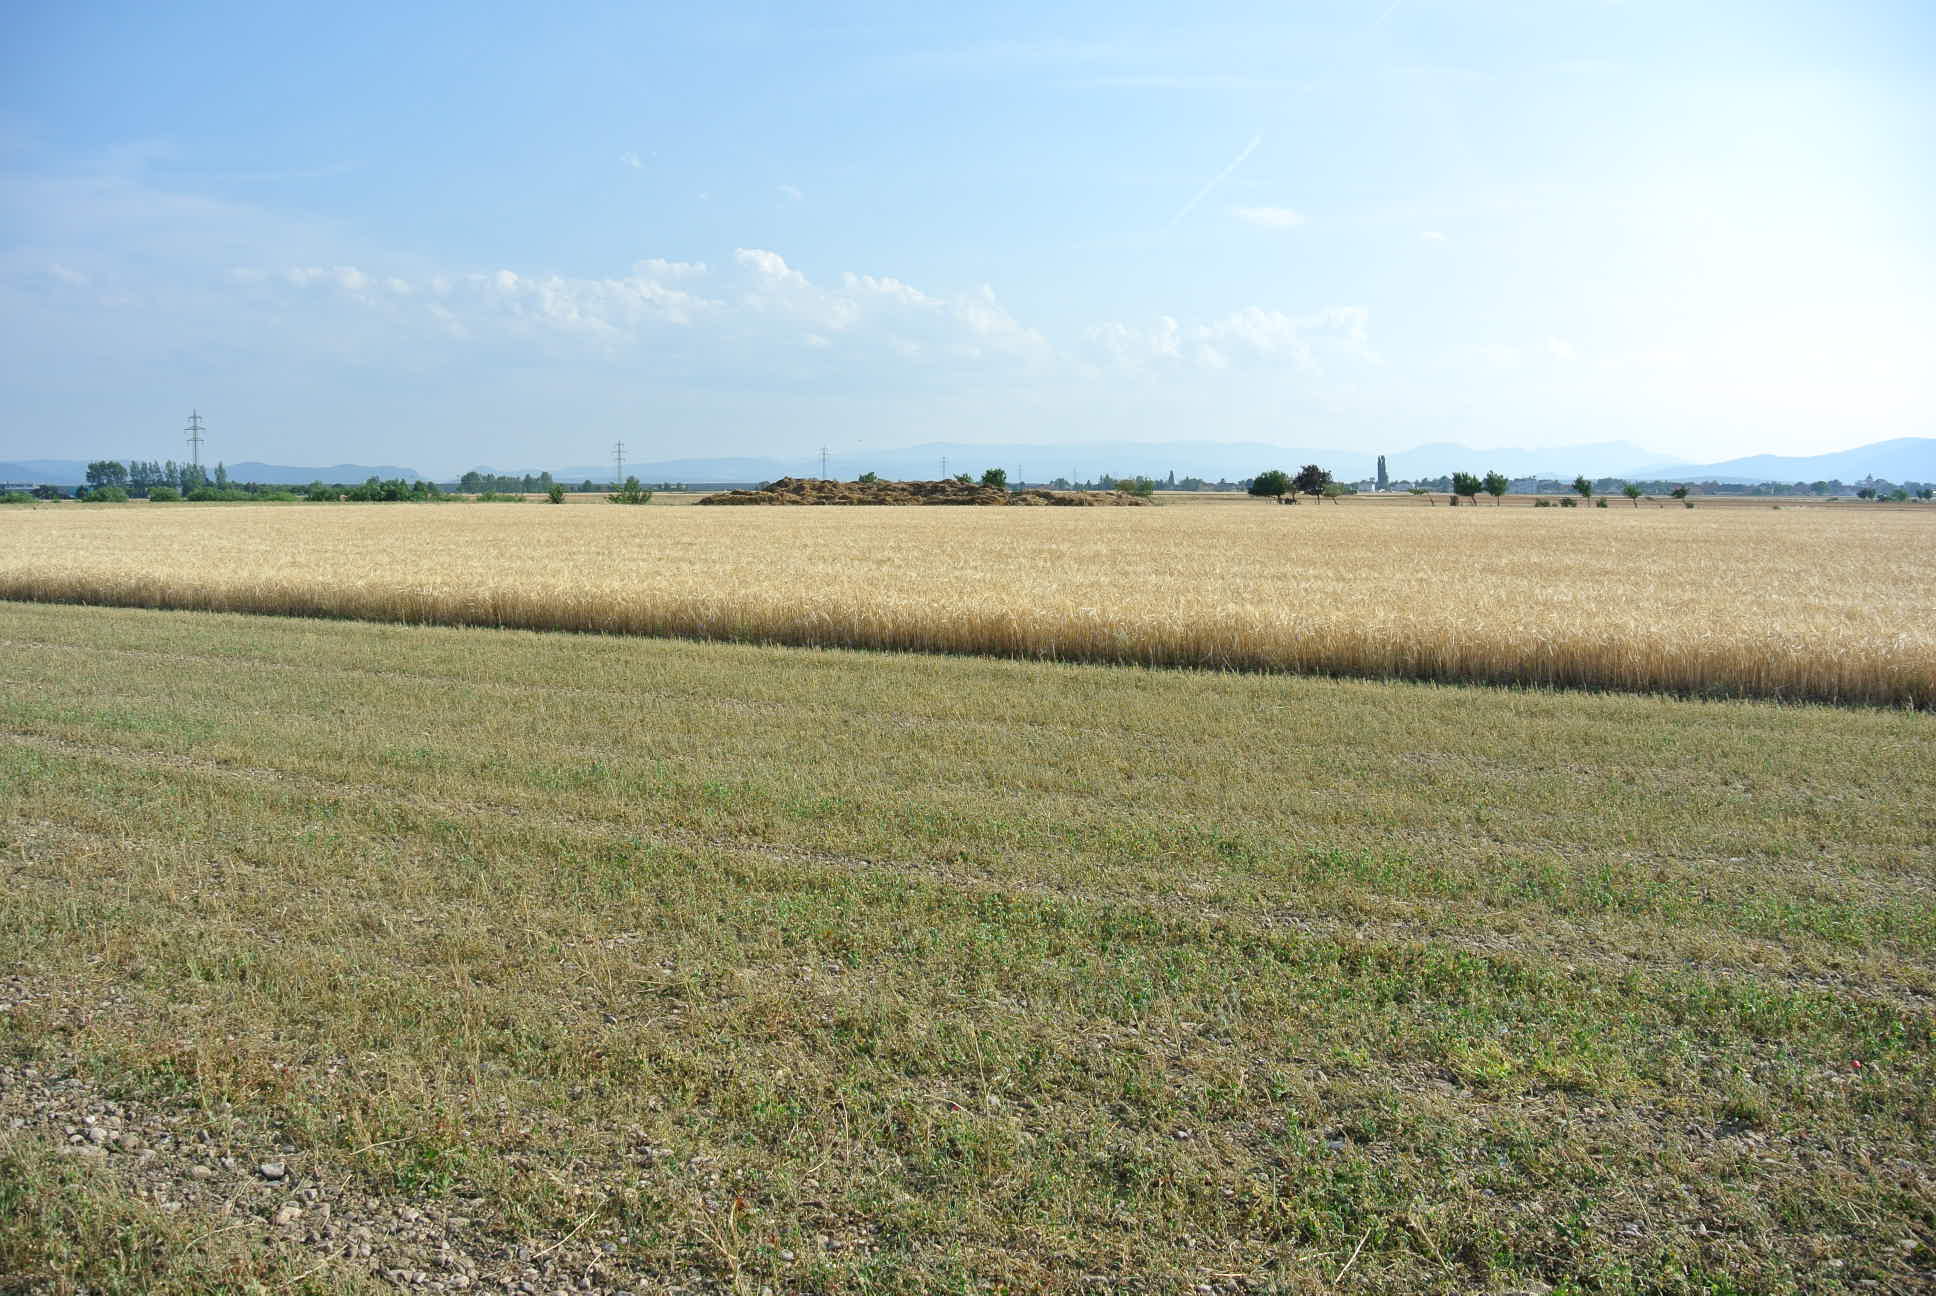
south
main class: Grassland
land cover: Grassland without tree/shrub cover
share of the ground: > 75 %
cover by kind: herbaceous plants 80 %, unconsolidated bare surface 20 %
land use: Agriculture (excluding fallow land and kitchen gardens)
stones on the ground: > 50 %
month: July
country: AT
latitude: 47.8166
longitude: 16.1603
